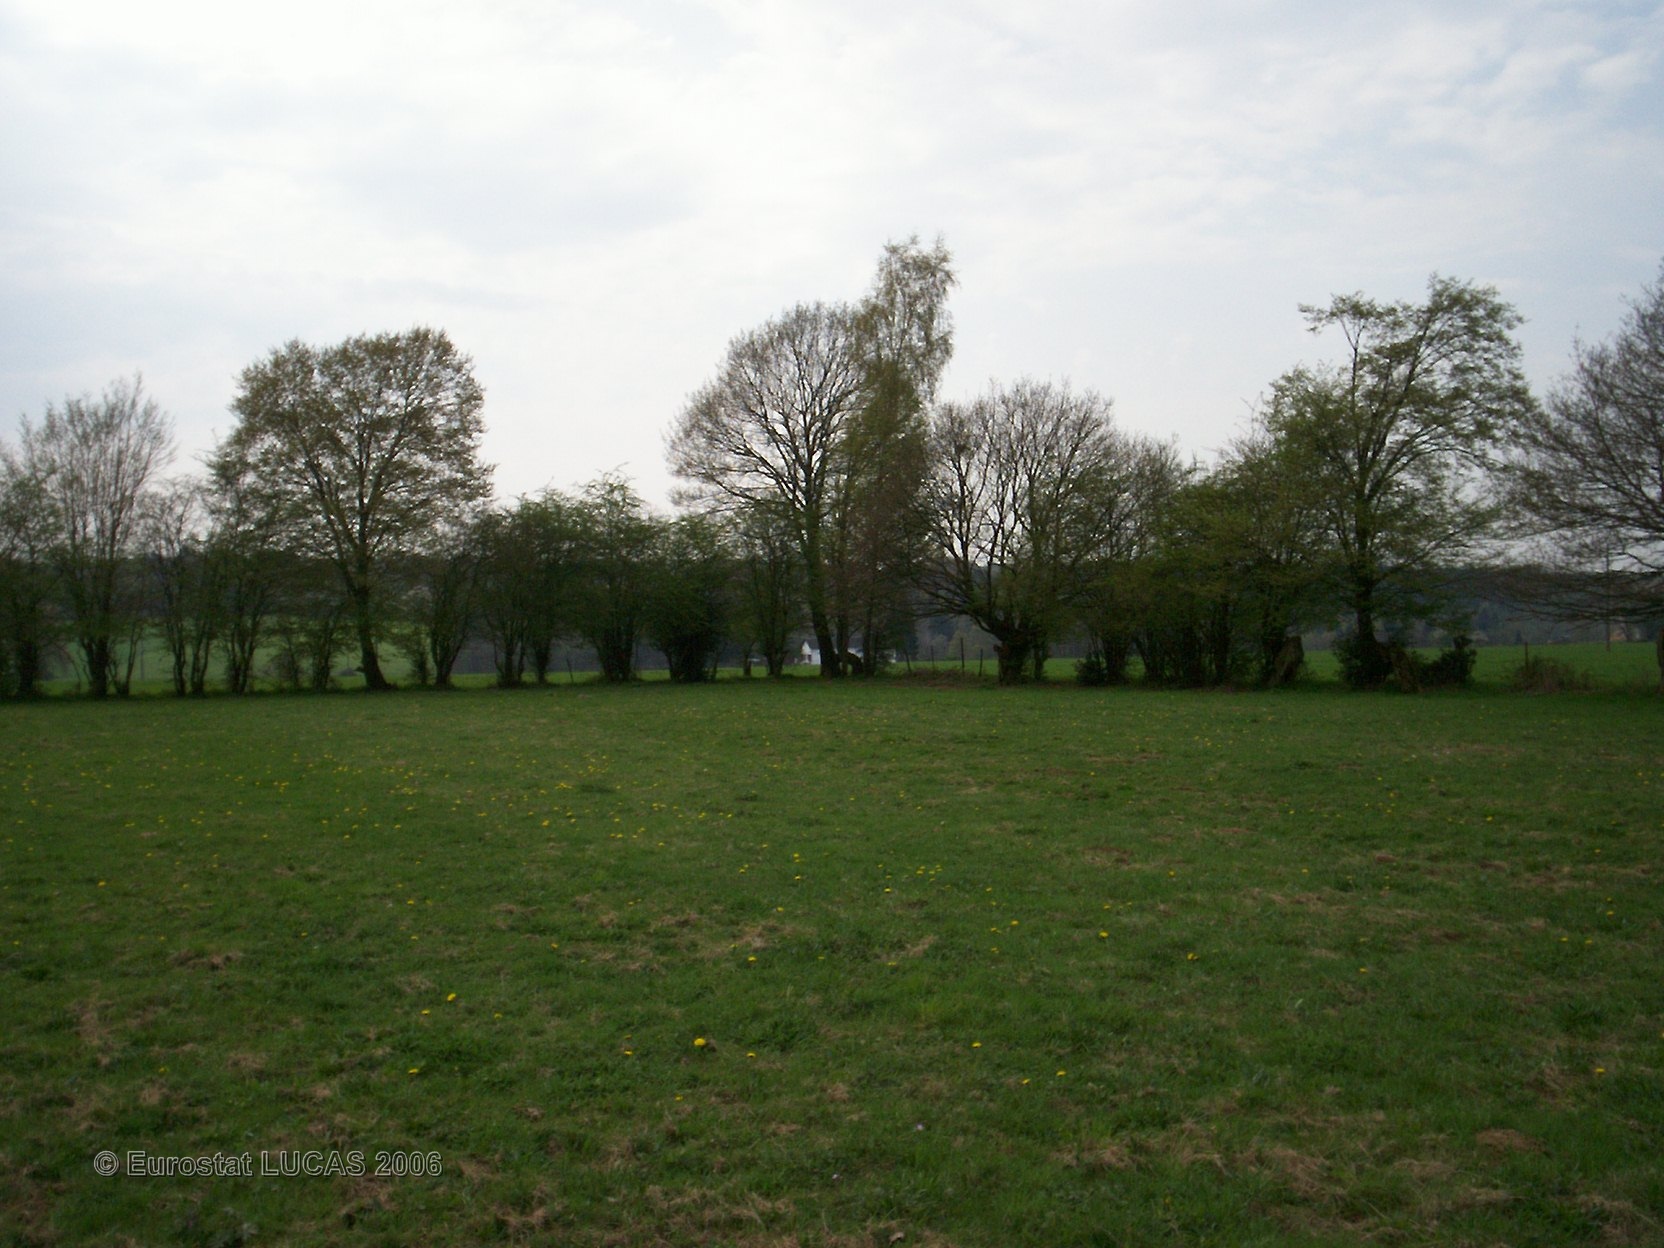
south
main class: Grassland
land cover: Grassland without tree/shrub cover
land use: Agriculture (excluding fallow land and kitchen gardens)
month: May
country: FR
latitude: 49.9334
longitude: 4.2973
